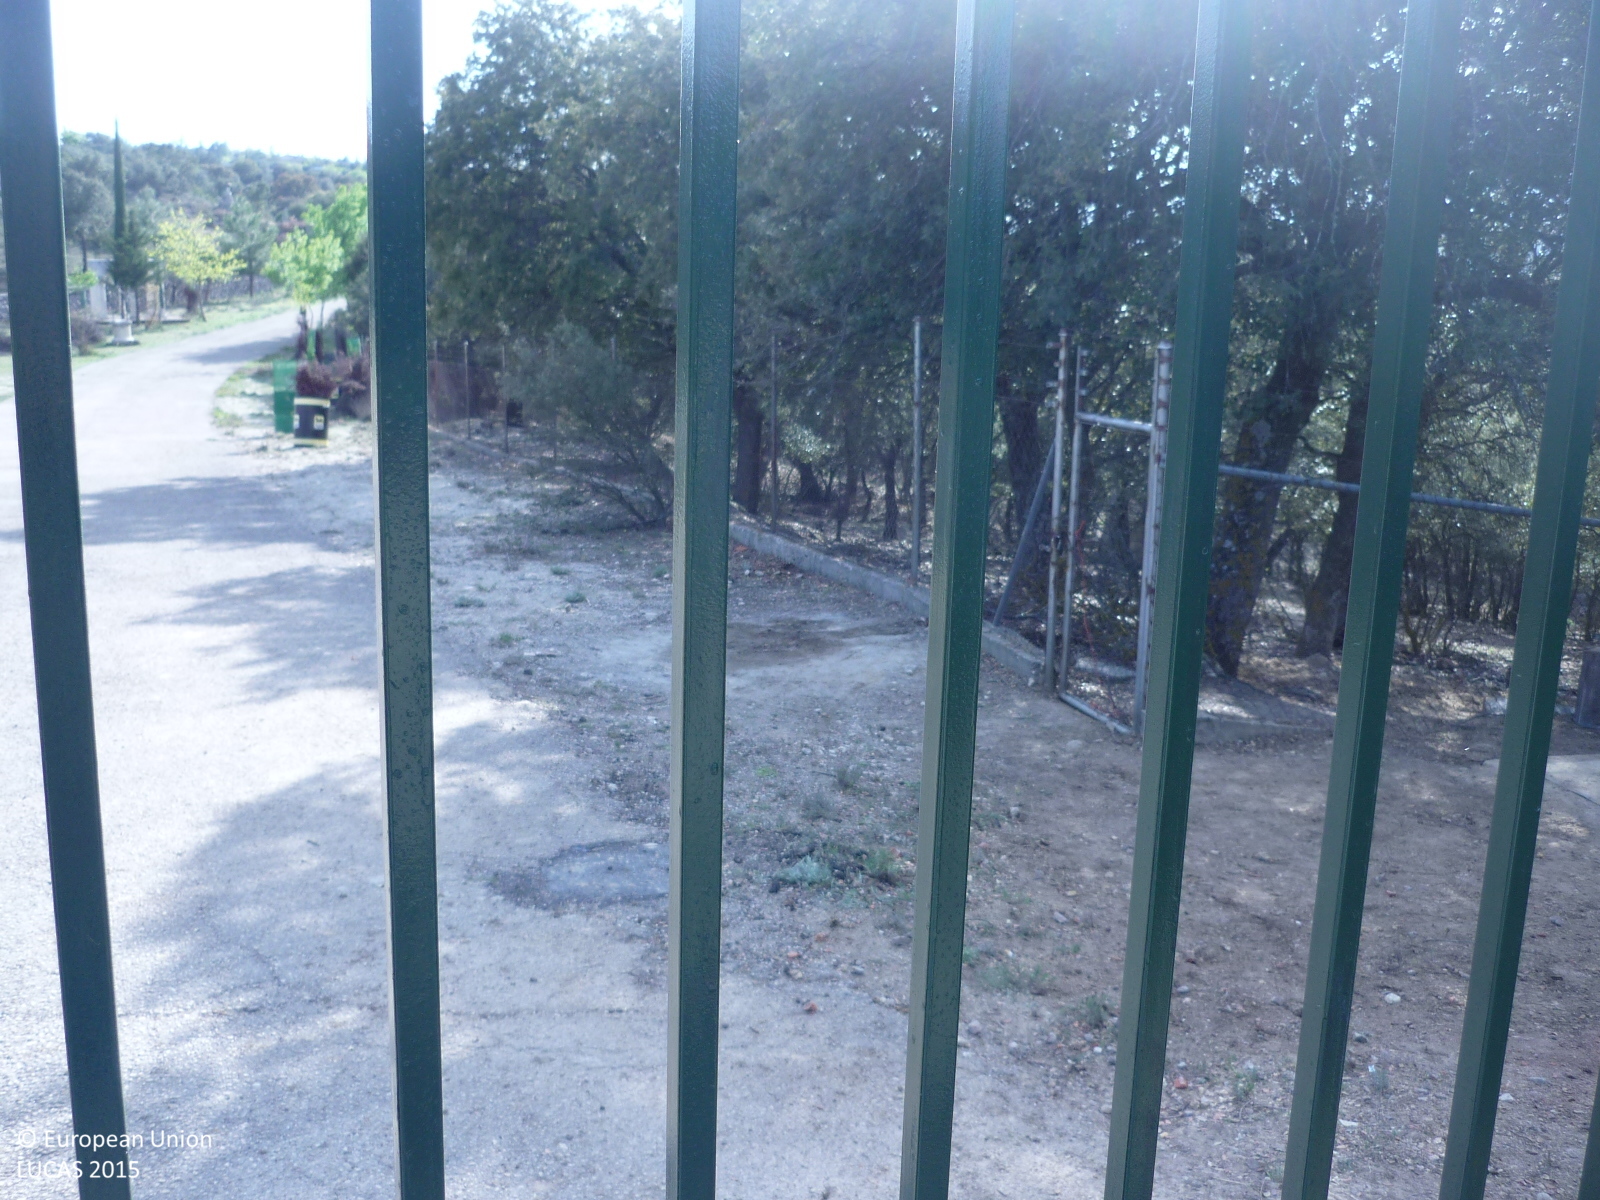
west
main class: Woodland
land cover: Broadleaved woodland
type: broadleaved evergreen forest
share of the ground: 50 - 75 %
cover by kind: broadleaved forest trees 60 %, herbaceous plants 20 %, shrubs 10 %, unconsolidated bare surface 10 %
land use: Forestry
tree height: < 5 m
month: April
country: ES
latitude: 40.8004
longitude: -3.5886
